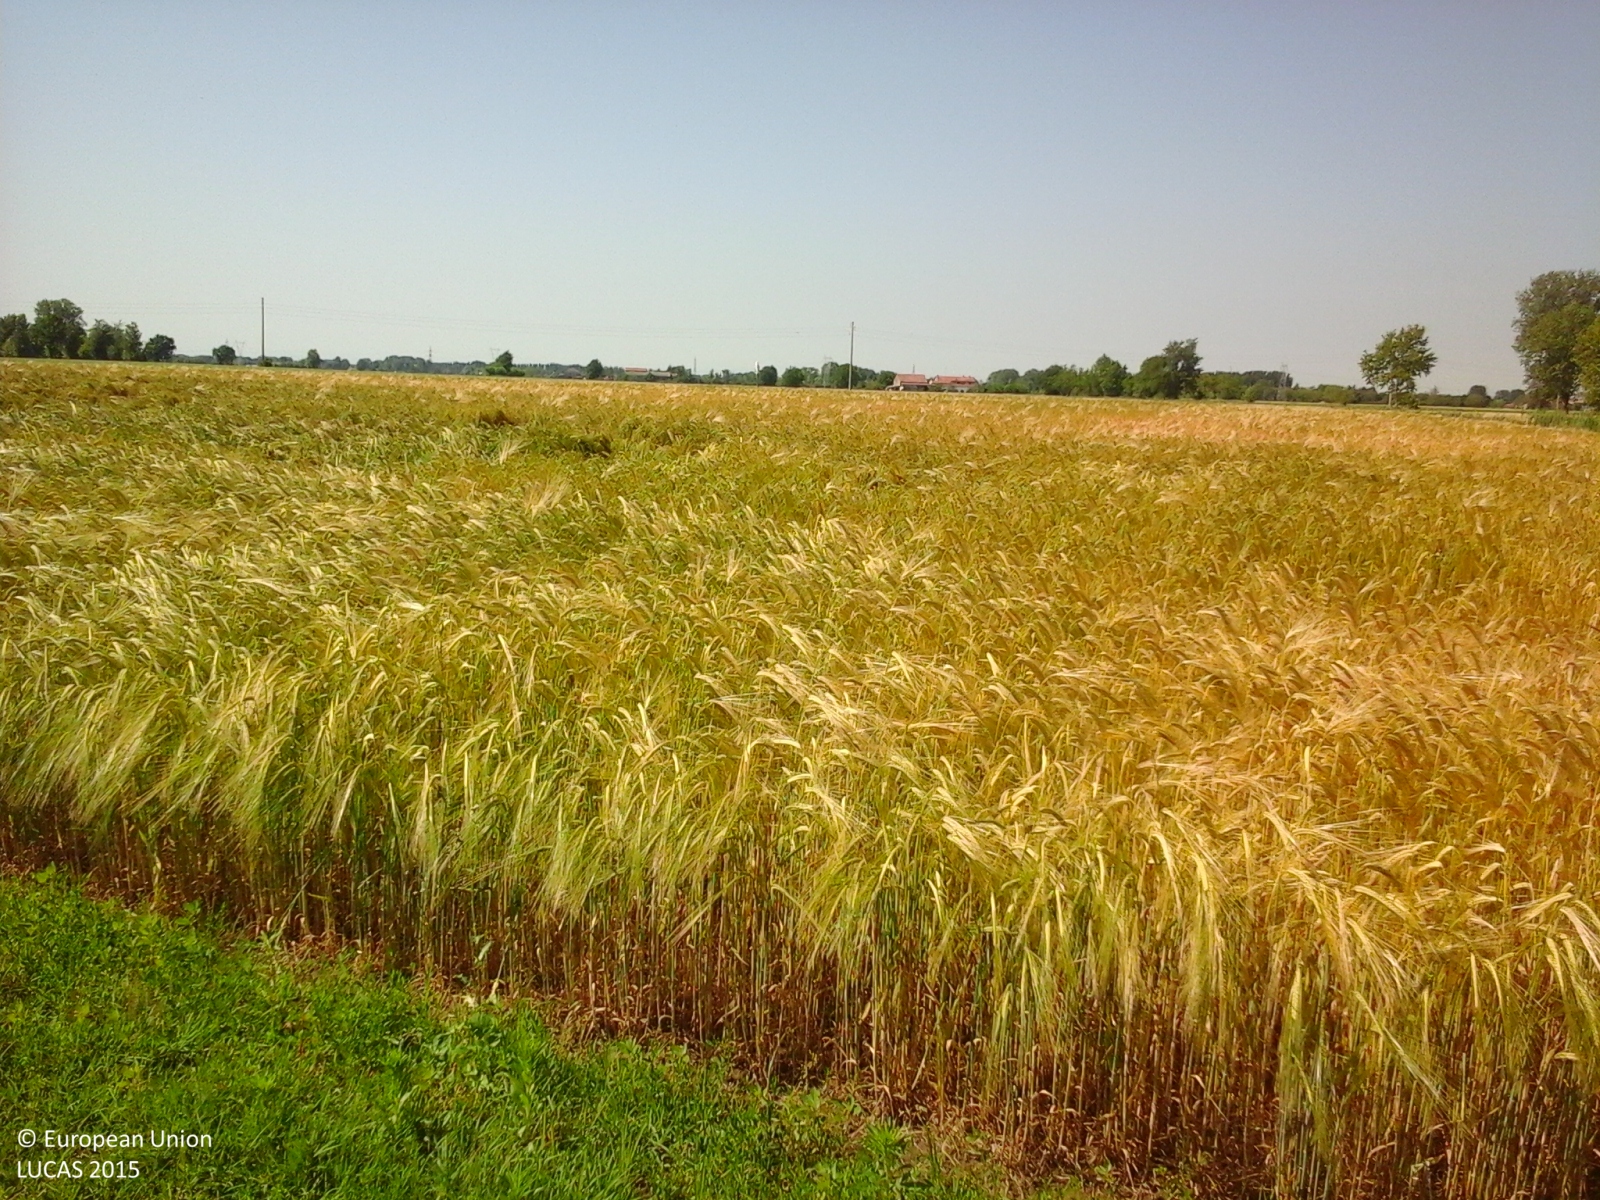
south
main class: Shrubland
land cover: Shrubland with sparse tree cover
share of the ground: > 75 %
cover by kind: shrubs 65 %, herbaceous plants 30 %, broadleaved forest trees 5 %
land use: Semi-natural and natural areas not in use
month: May
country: IT
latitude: 45.1398
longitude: 10.9266
